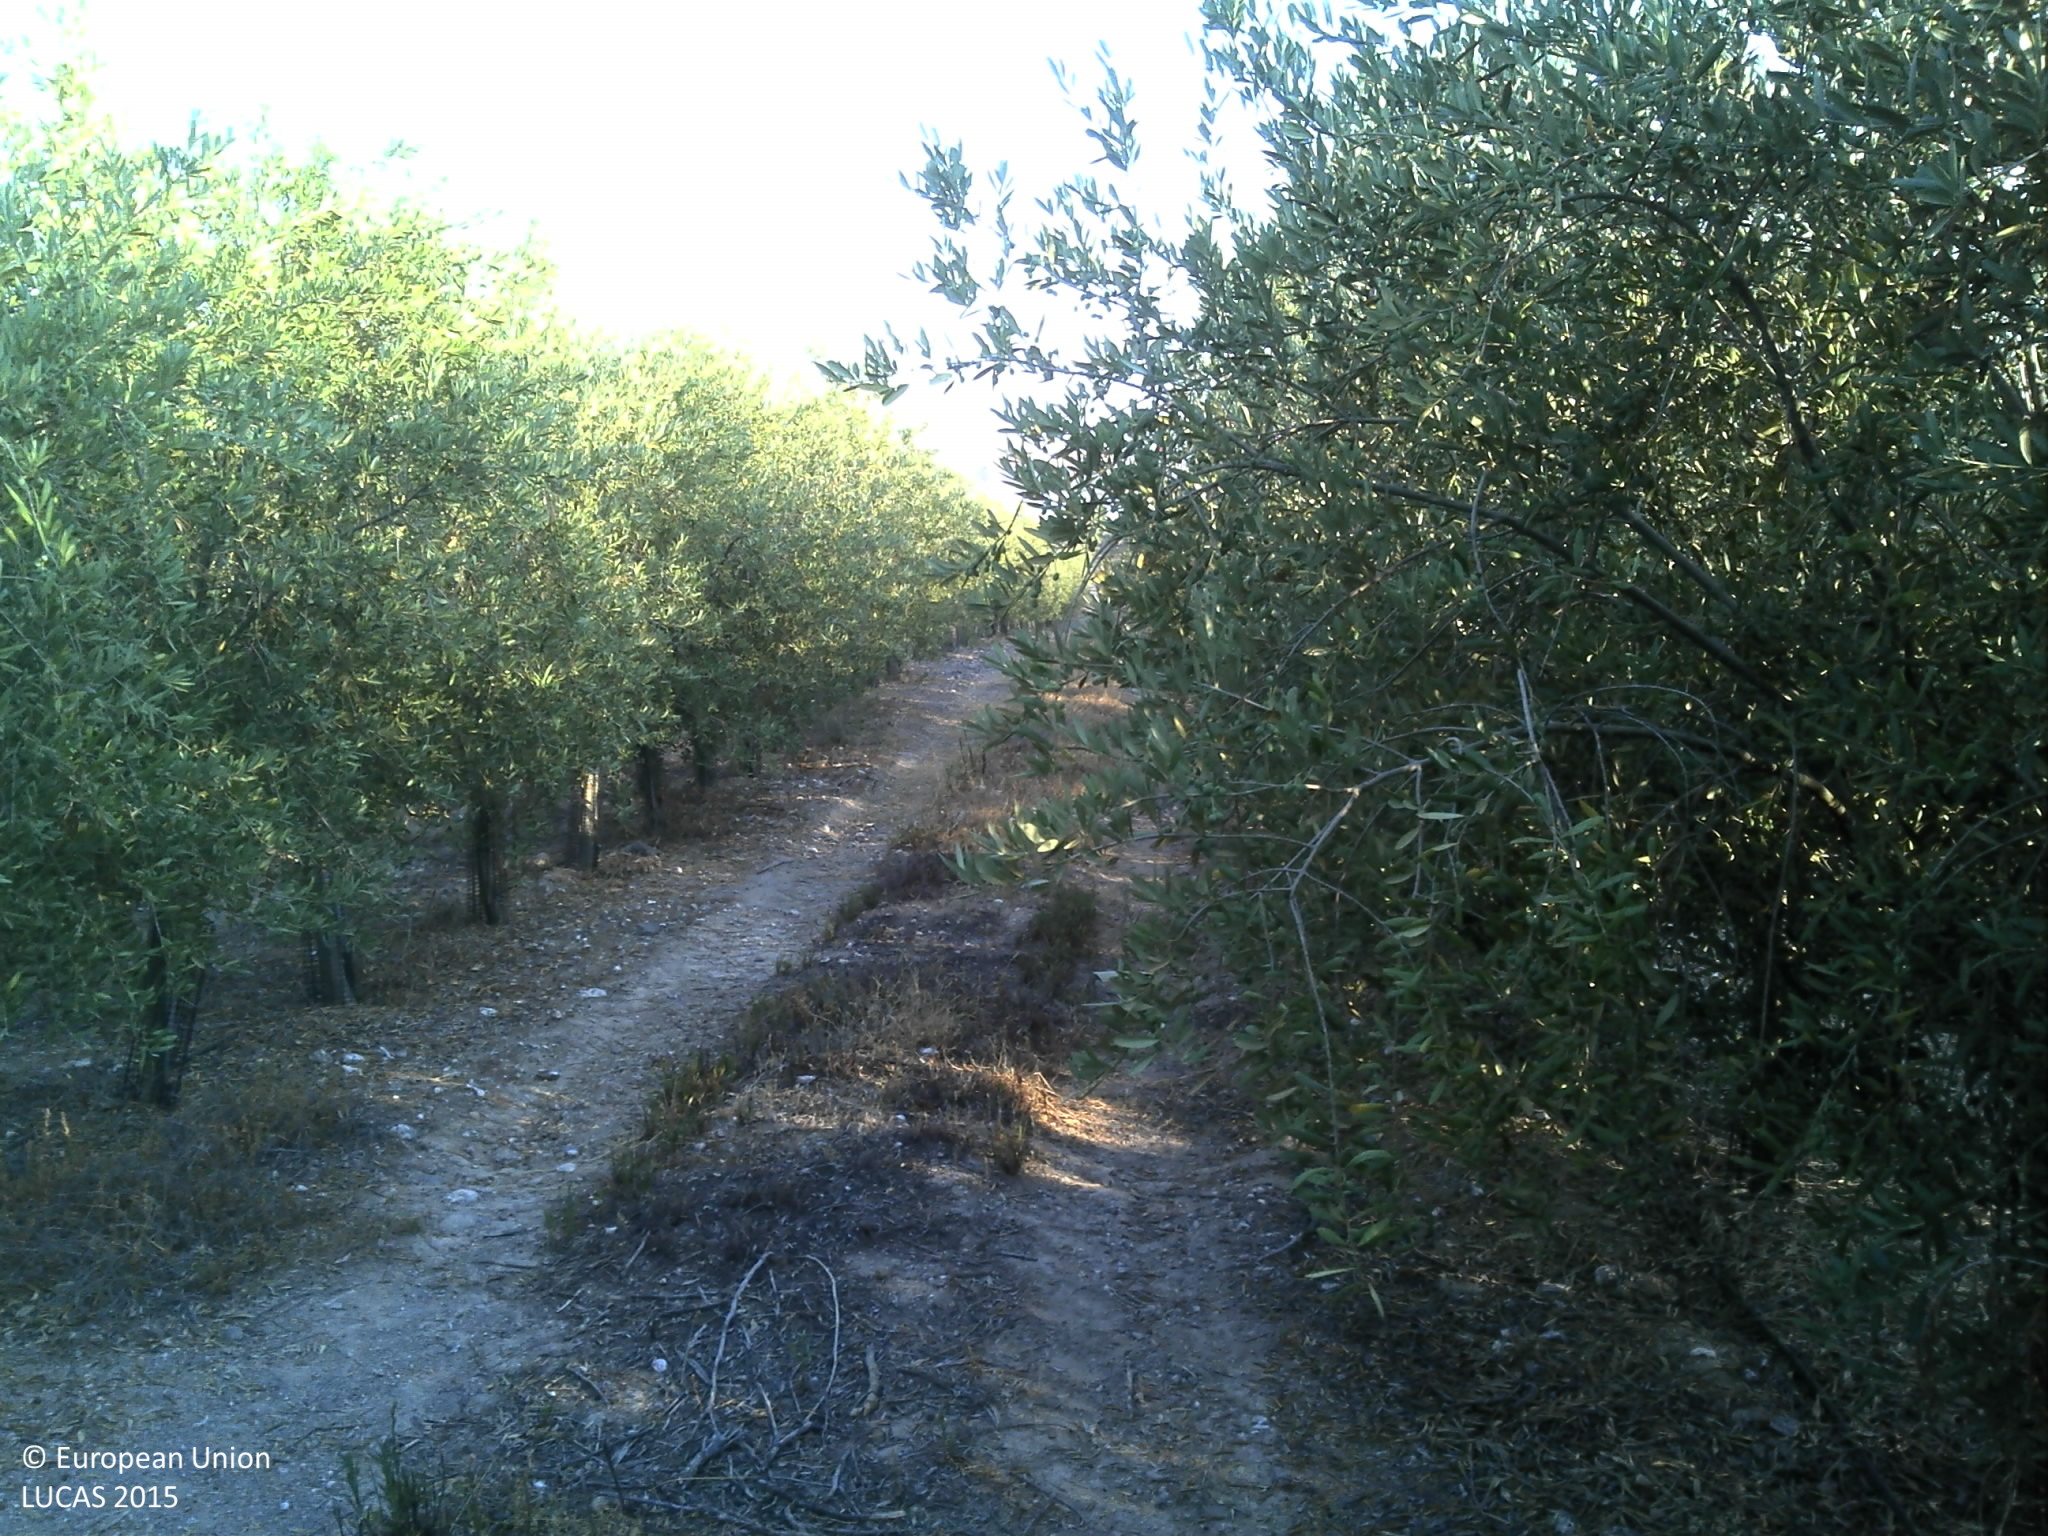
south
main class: Cropland
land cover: Olive groves
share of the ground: 50 - 75 %
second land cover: Grassland without tree/shrub cover
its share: 10 - 25 %
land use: Agriculture (excluding fallow land and kitchen gardens)
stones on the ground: < 10 %
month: June
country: PT
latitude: 38.3162
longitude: -7.3727
